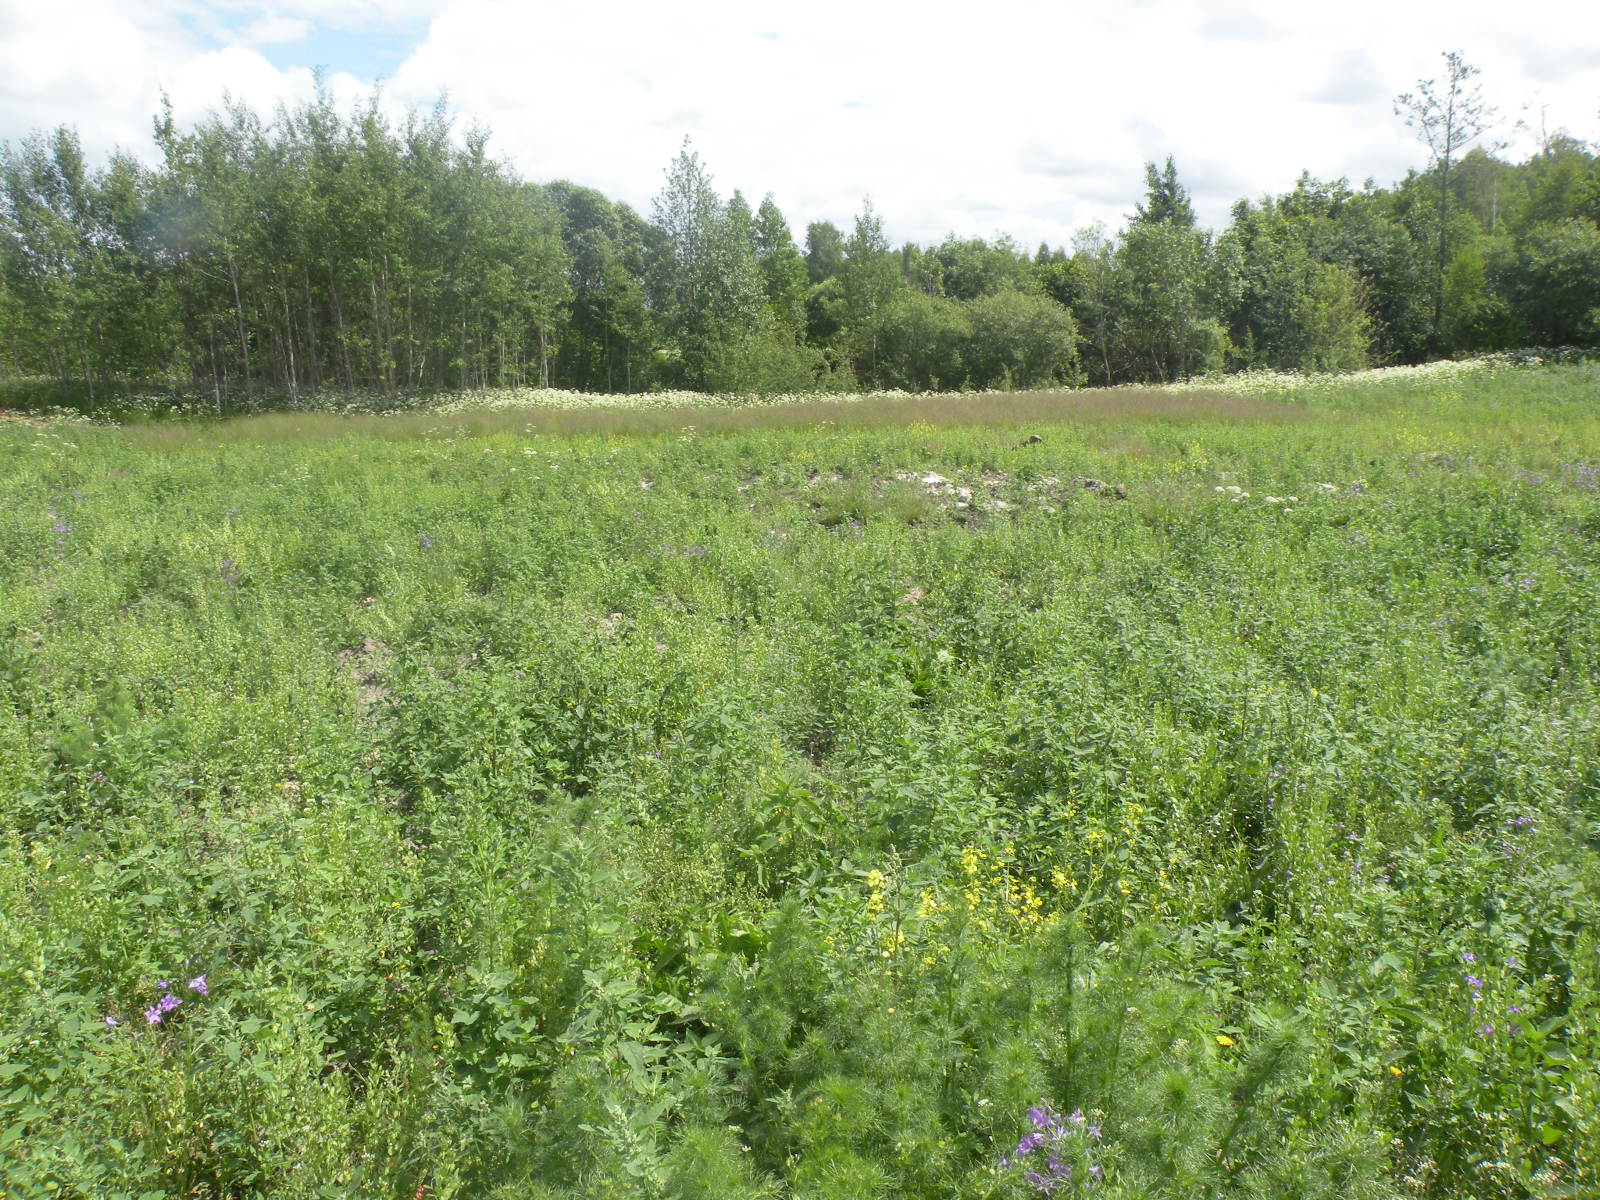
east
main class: Grassland
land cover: Spontaneously vegetated surfaces
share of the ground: > 75 %
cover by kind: herbaceous plants 95 %, shrubs 5 %
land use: Fallow land
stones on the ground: < 10 %
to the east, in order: Spontaneously vegetated surfaces; Broadleaved woodland; Ditches and canals; Broadleaved woodland; Common wheat
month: June
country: LV
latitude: 56.0138
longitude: 27.0247
